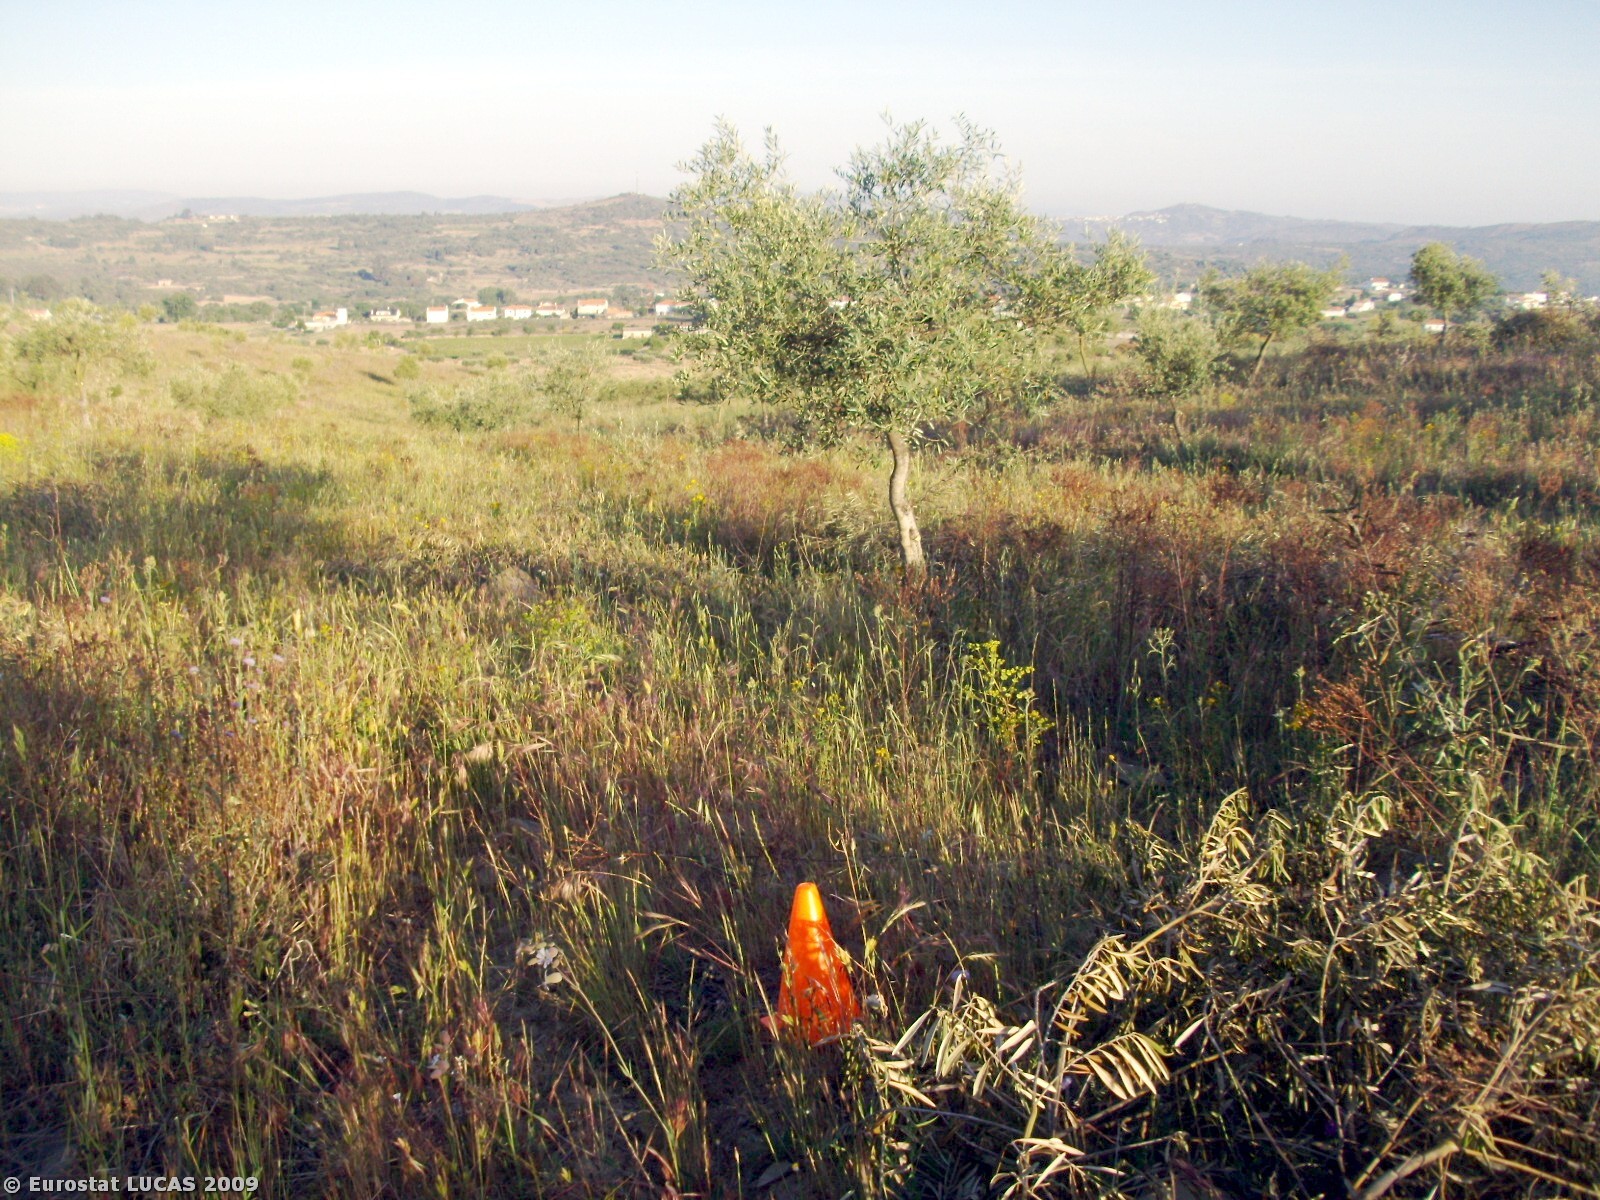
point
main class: Cropland
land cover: Olive groves
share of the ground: 25 - 50 %
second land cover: Spontaneously vegetated surfaces
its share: > 75 %
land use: Agriculture (excluding fallow land and kitchen gardens)
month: May
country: PT
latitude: 41.0570
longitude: -7.2114
